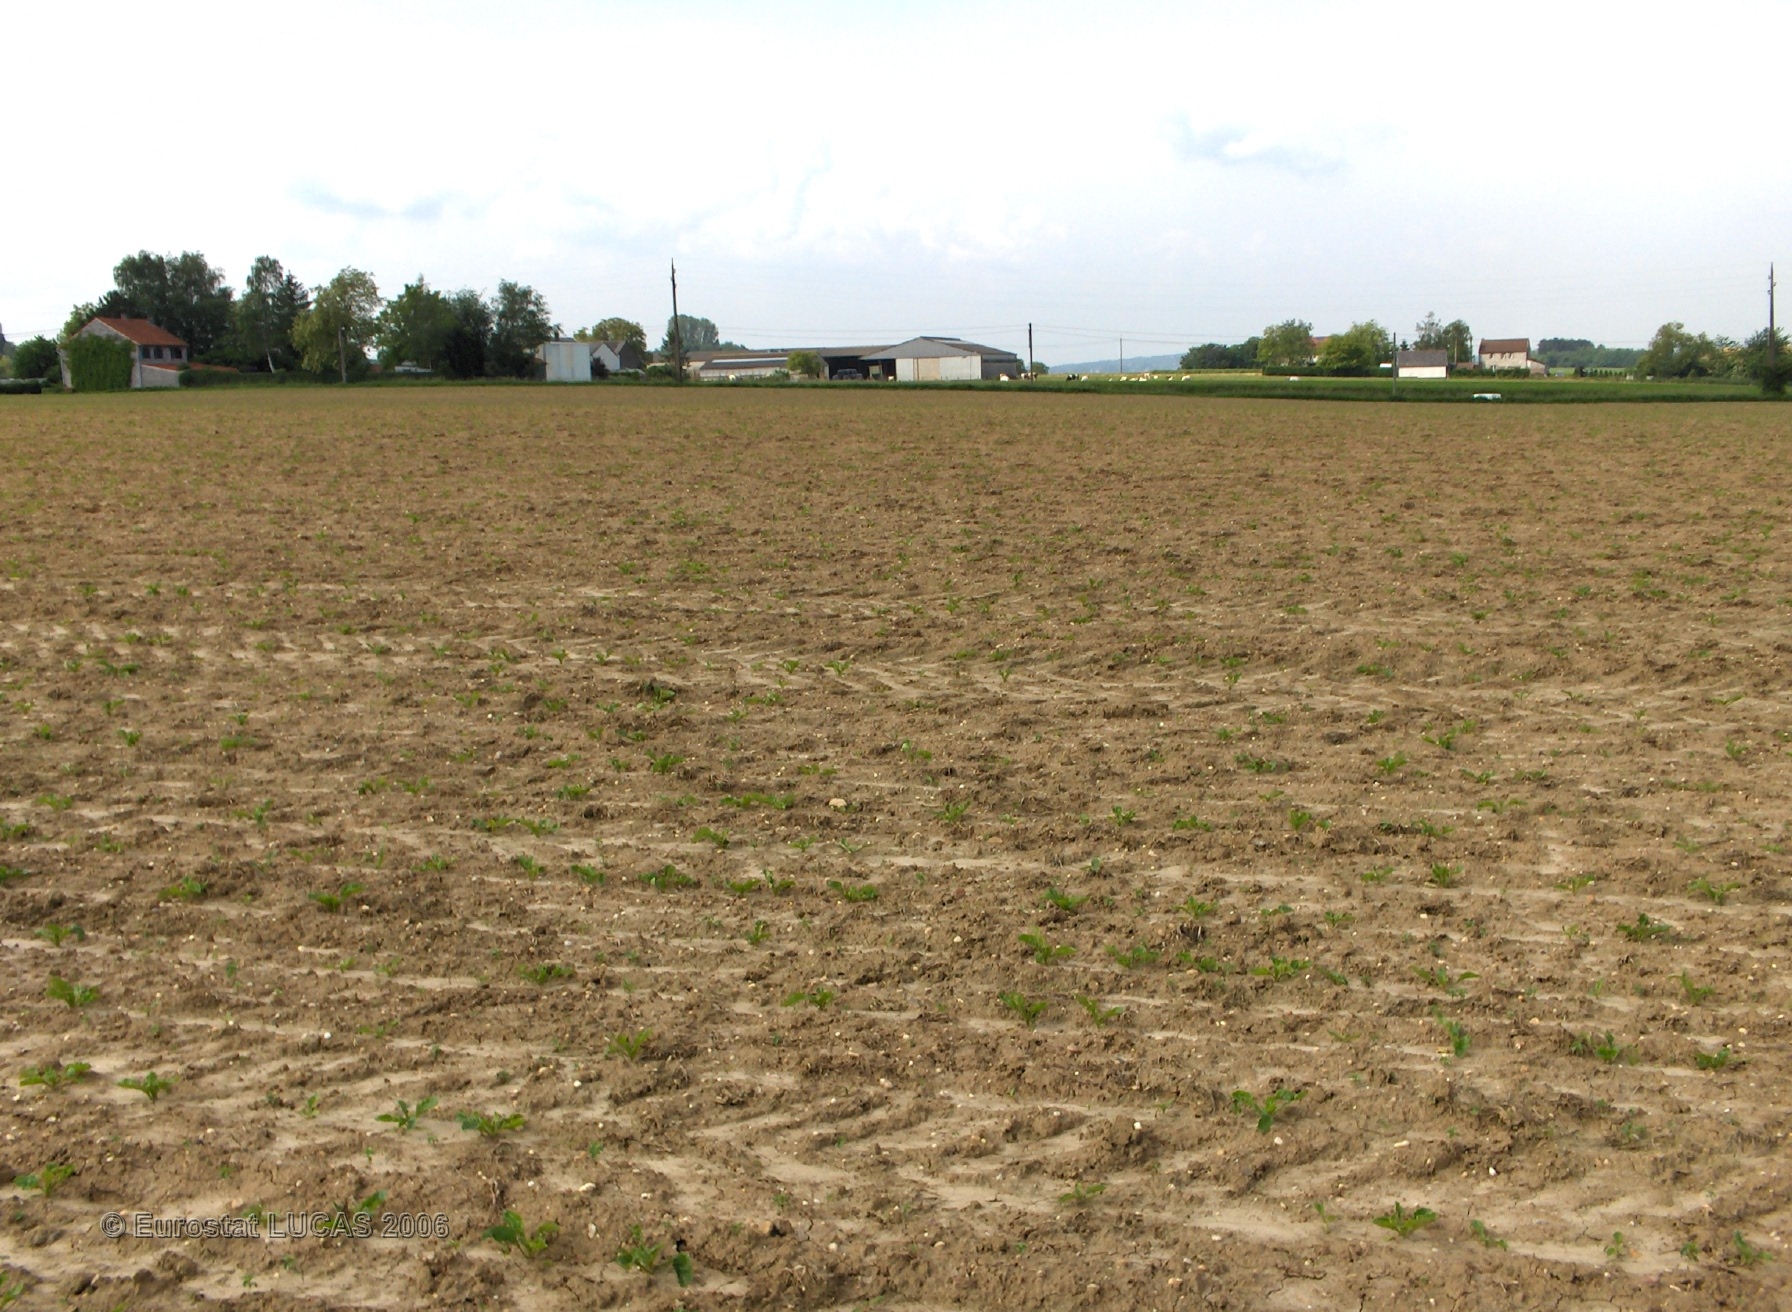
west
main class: Cropland
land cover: Sugar beet
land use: Agriculture (excluding fallow land and kitchen gardens)
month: May
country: BE
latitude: 50.5700
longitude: 5.2112
